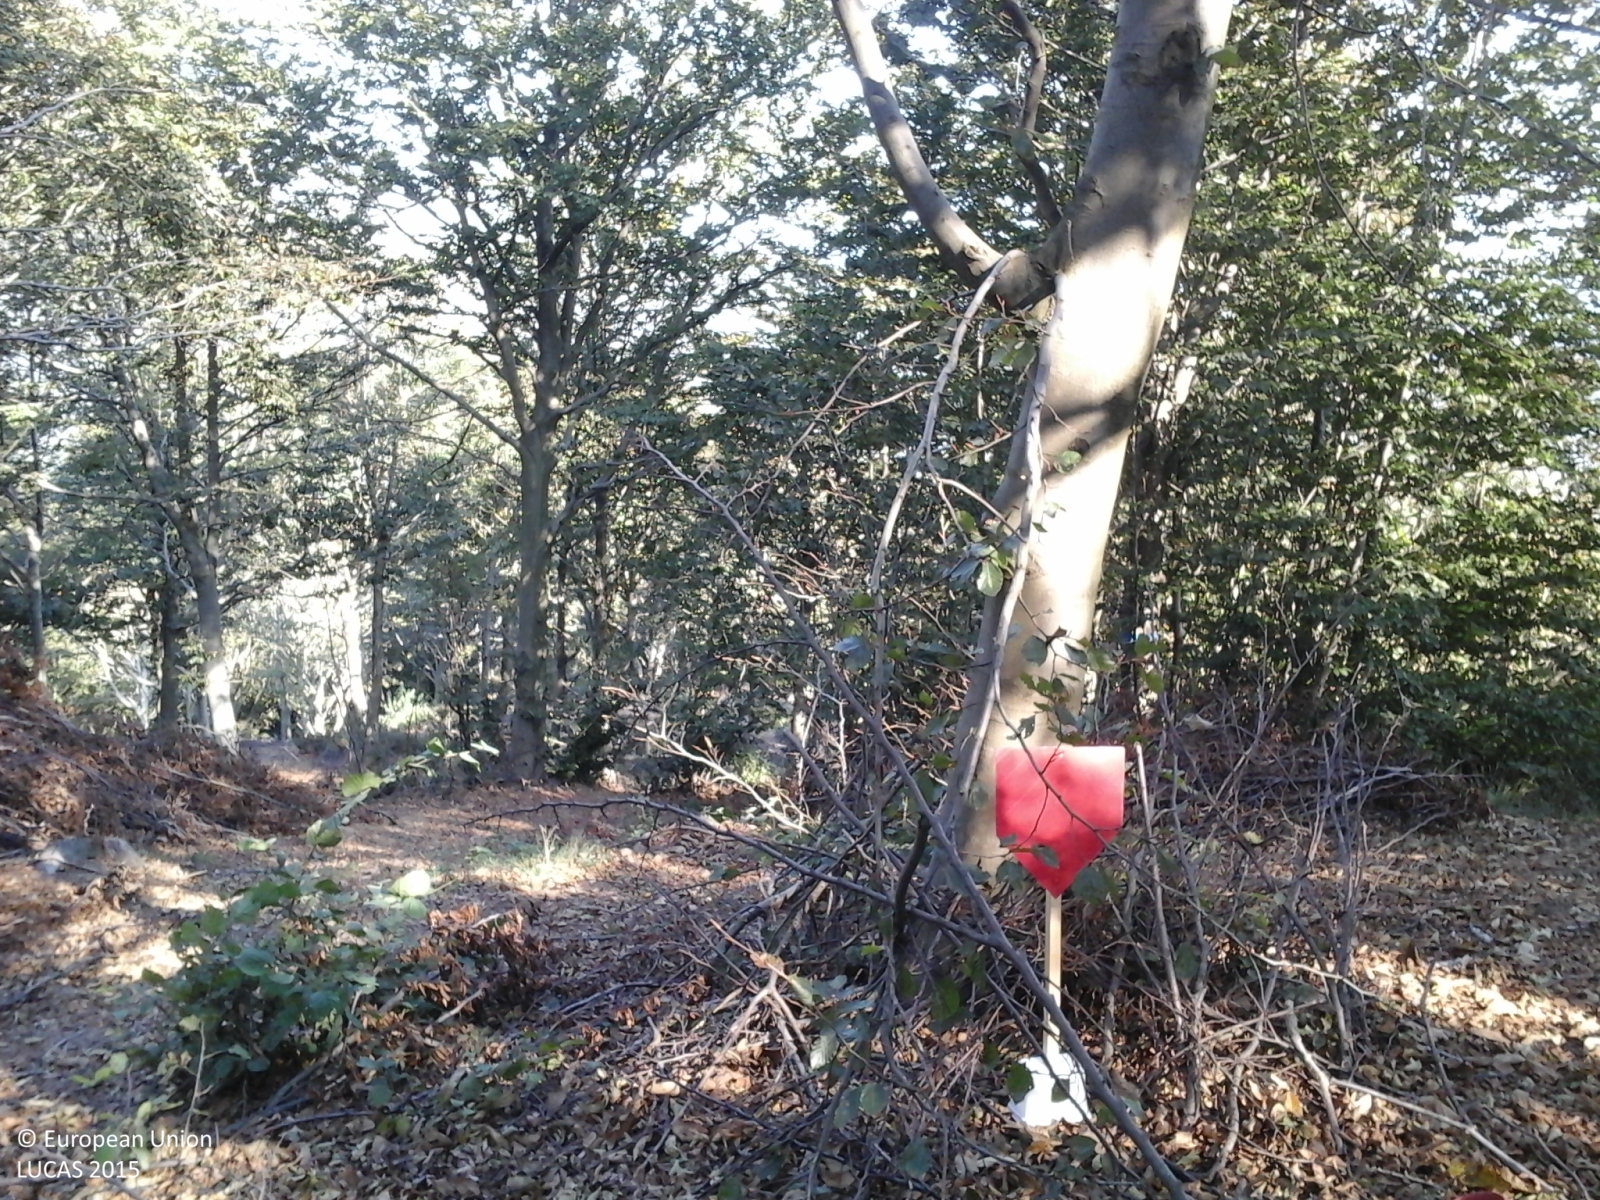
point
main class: Woodland
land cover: Broadleaved woodland
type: beech forest
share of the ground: > 75 %
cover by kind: broadleaved forest trees 100 %
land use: Forestry
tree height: > 5 m
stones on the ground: 25 - 50 %
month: September
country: IT
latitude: 44.4113
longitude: 8.4588
